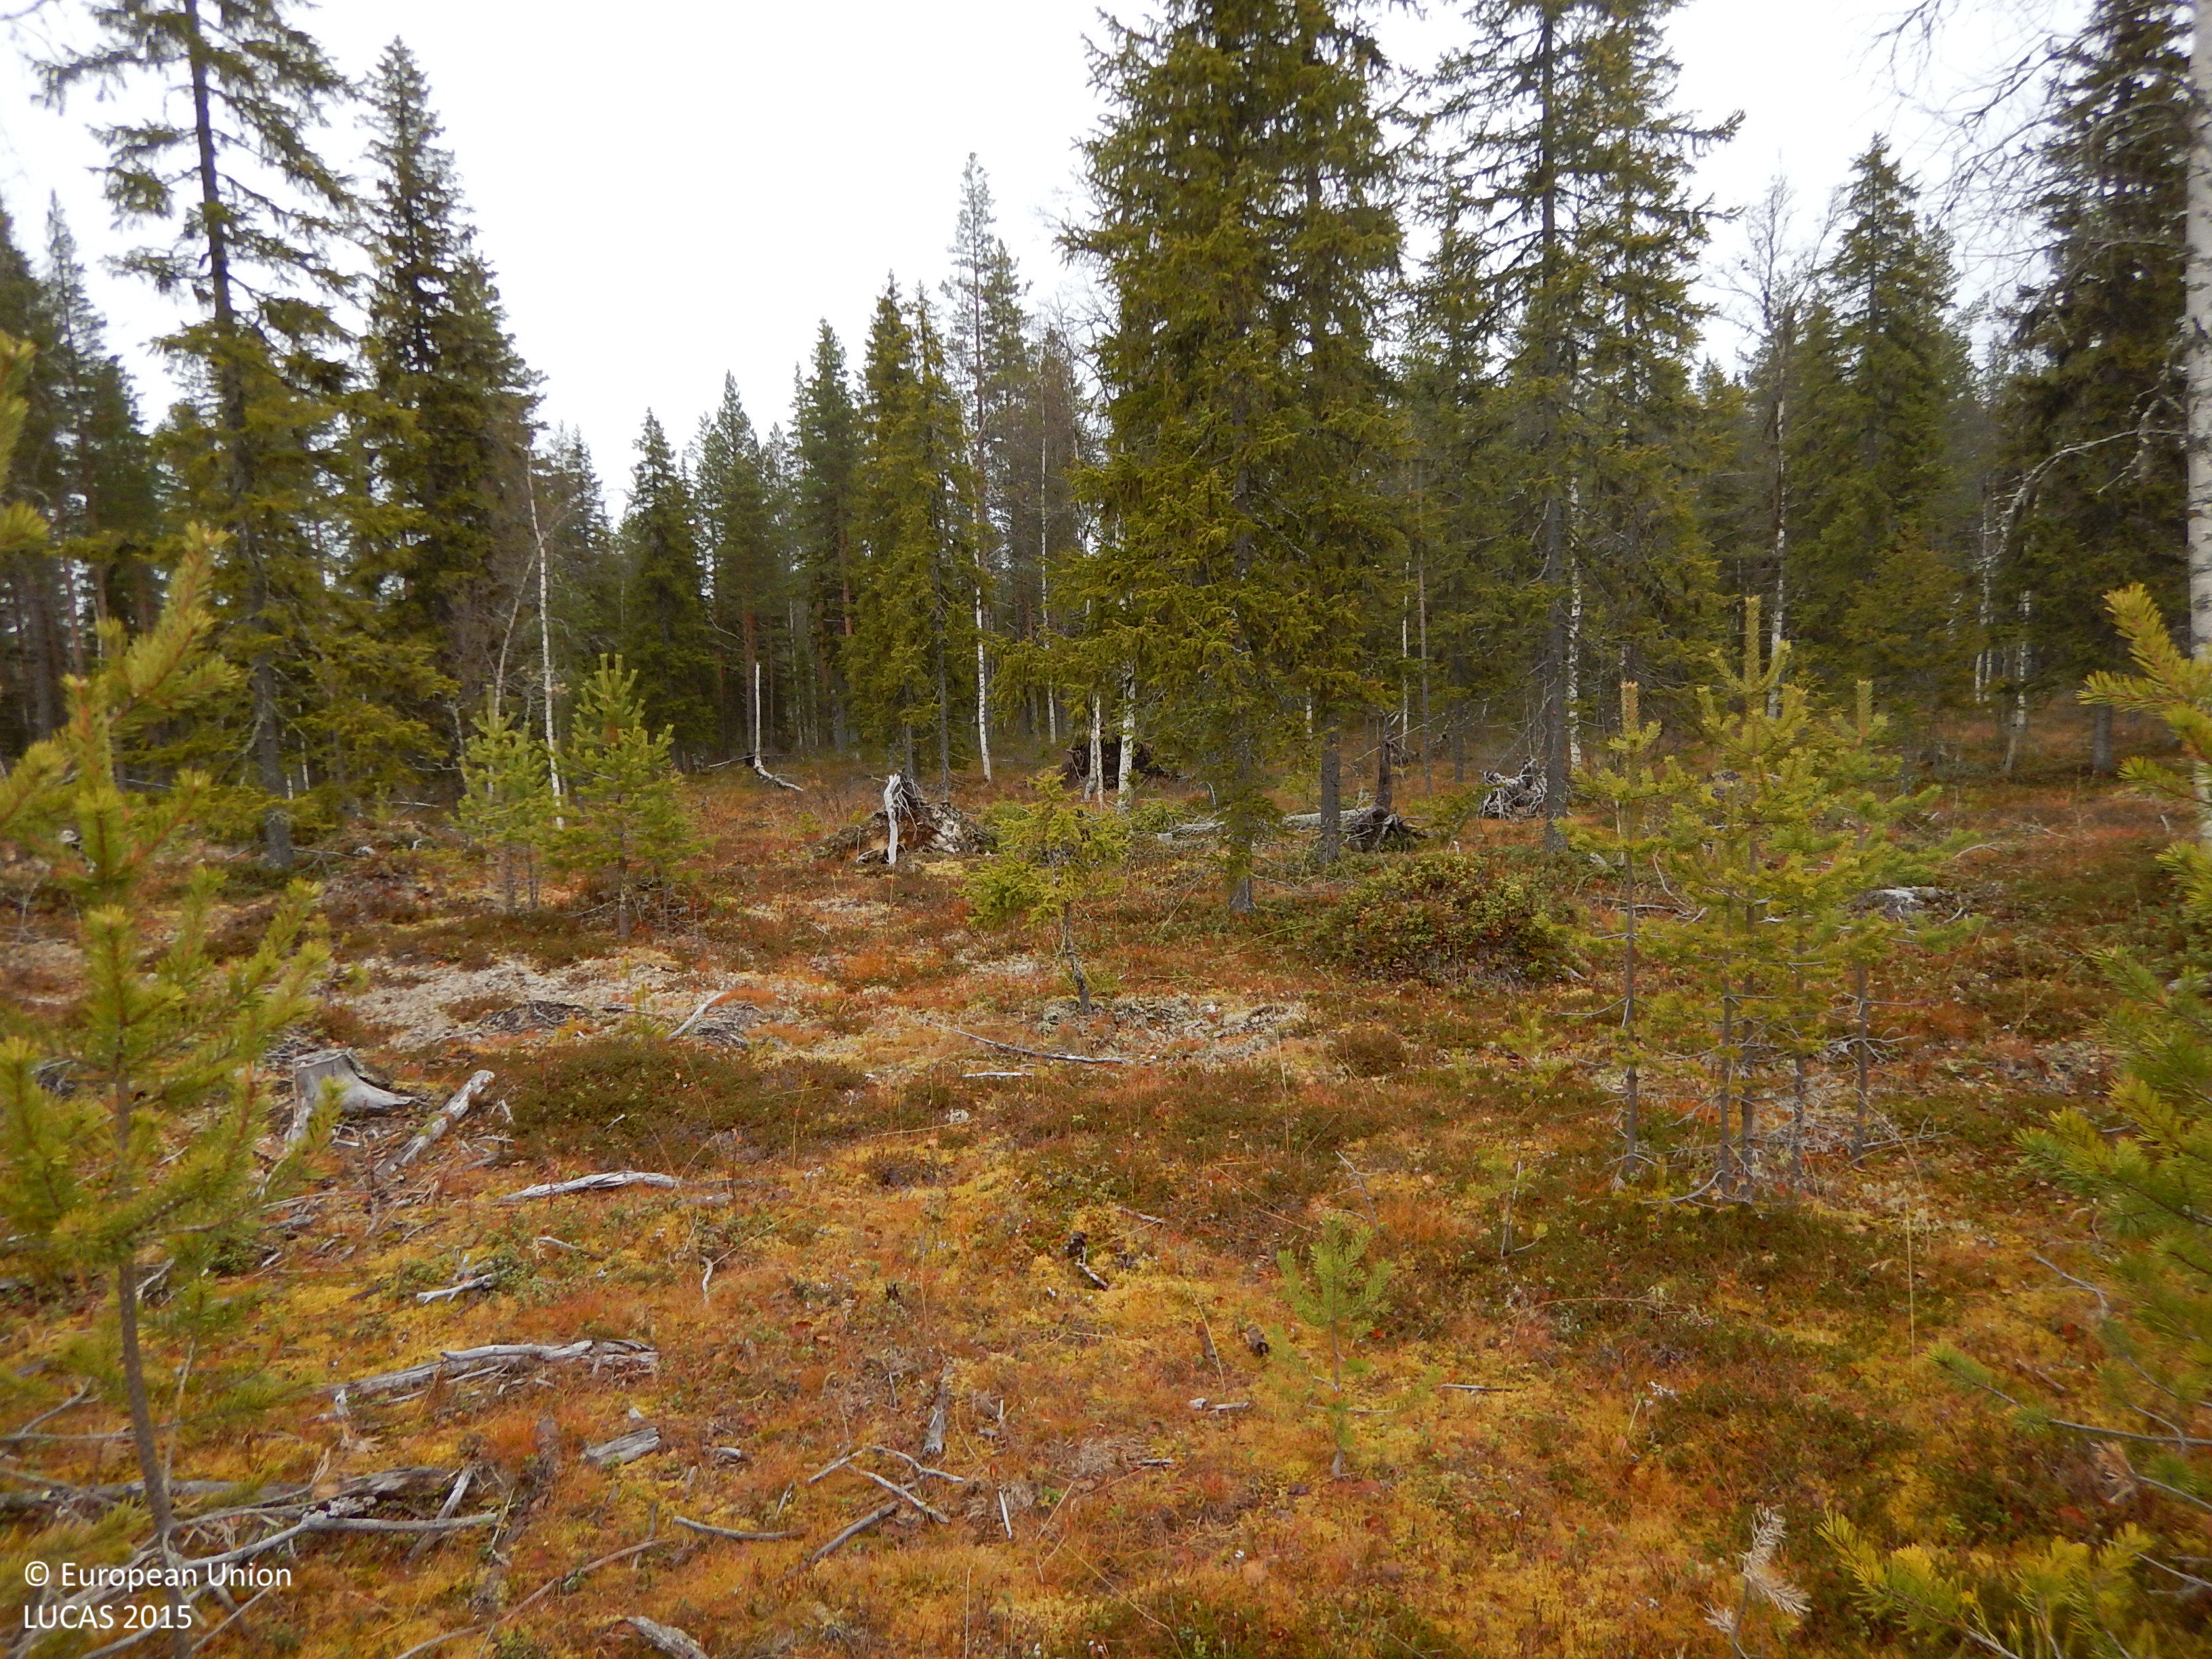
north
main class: Woodland
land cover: Pine dominated coniferous woodland
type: boreal forest
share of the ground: 50 - 75 %
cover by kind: coniferous forest trees 45 %, shrubs 20 %, herbaceous plants 15 %, lichens and mosses 15 %, broadleaved forest trees 5 %
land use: Forestry
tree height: < 5 m
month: October
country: SE
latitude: 65.1643
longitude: 20.1895
